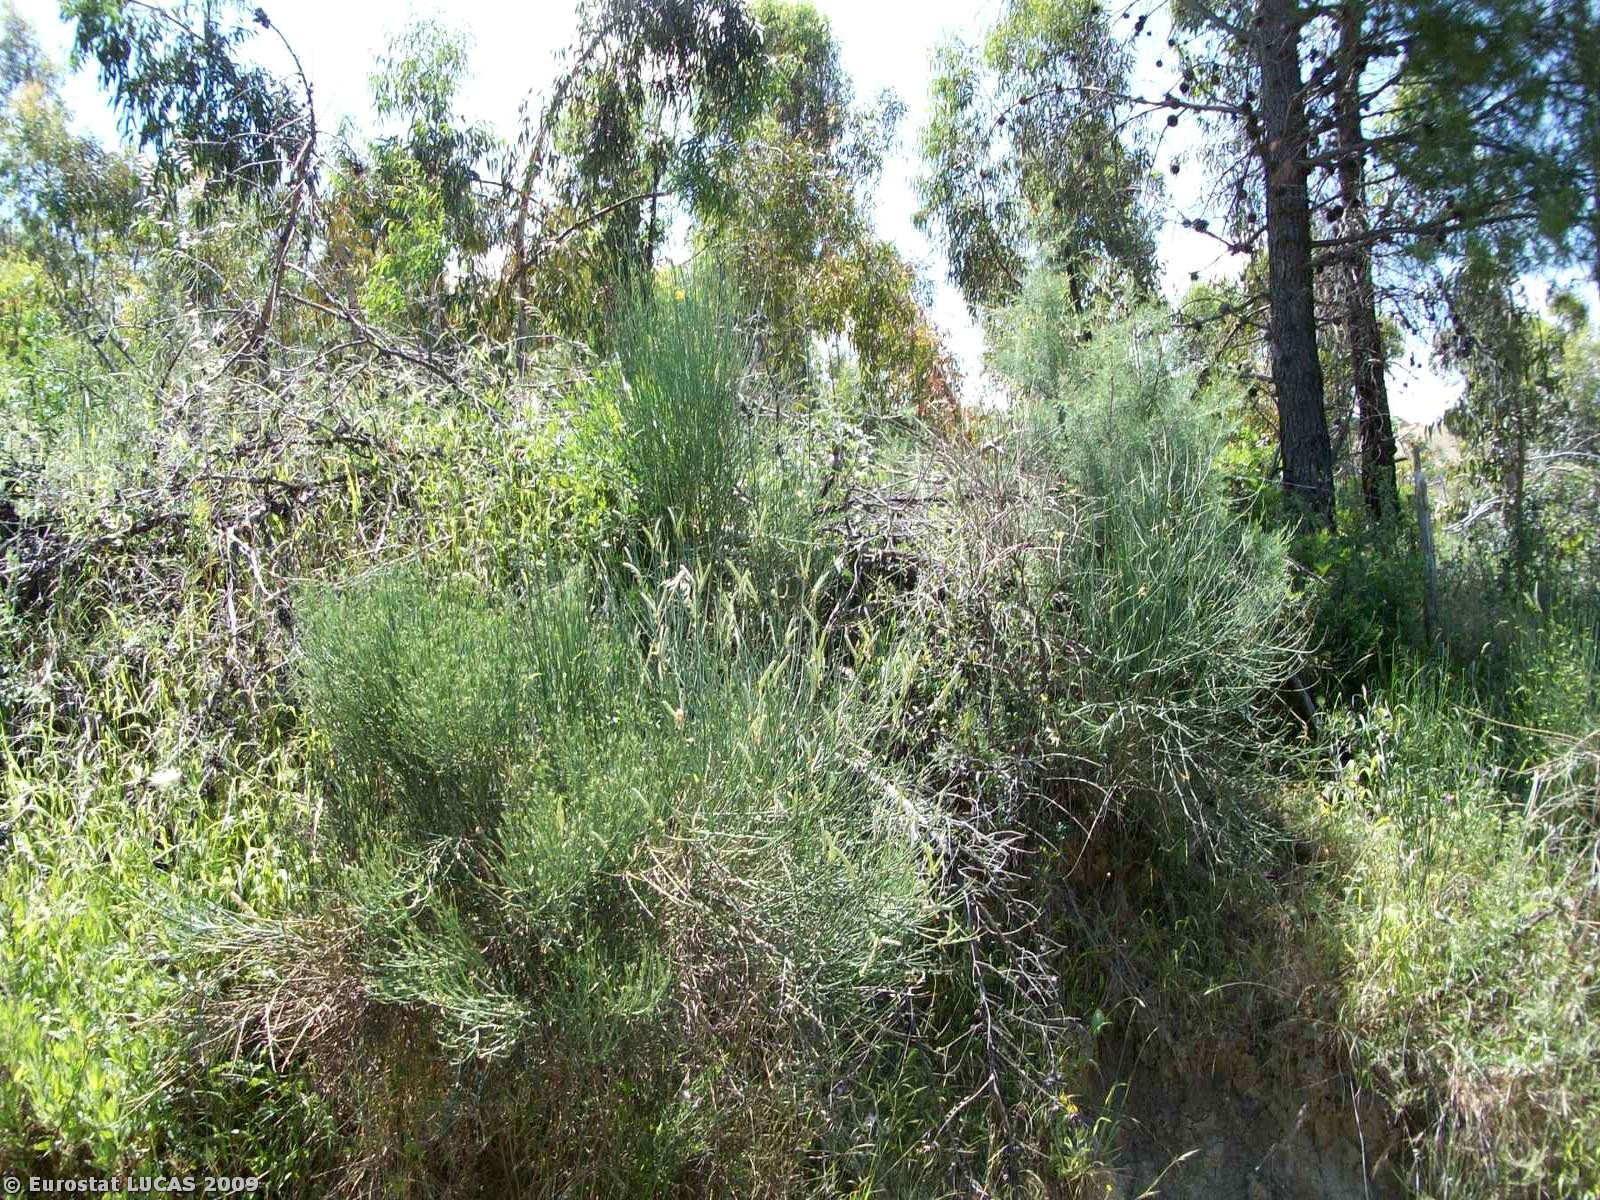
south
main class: Woodland
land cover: Broadleaved woodland
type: thermophilous deciduous forest
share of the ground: > 75 %
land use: Agriculture (excluding fallow land and kitchen gardens)
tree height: > 5 m
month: June
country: IT
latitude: 39.5276
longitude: 16.7289
